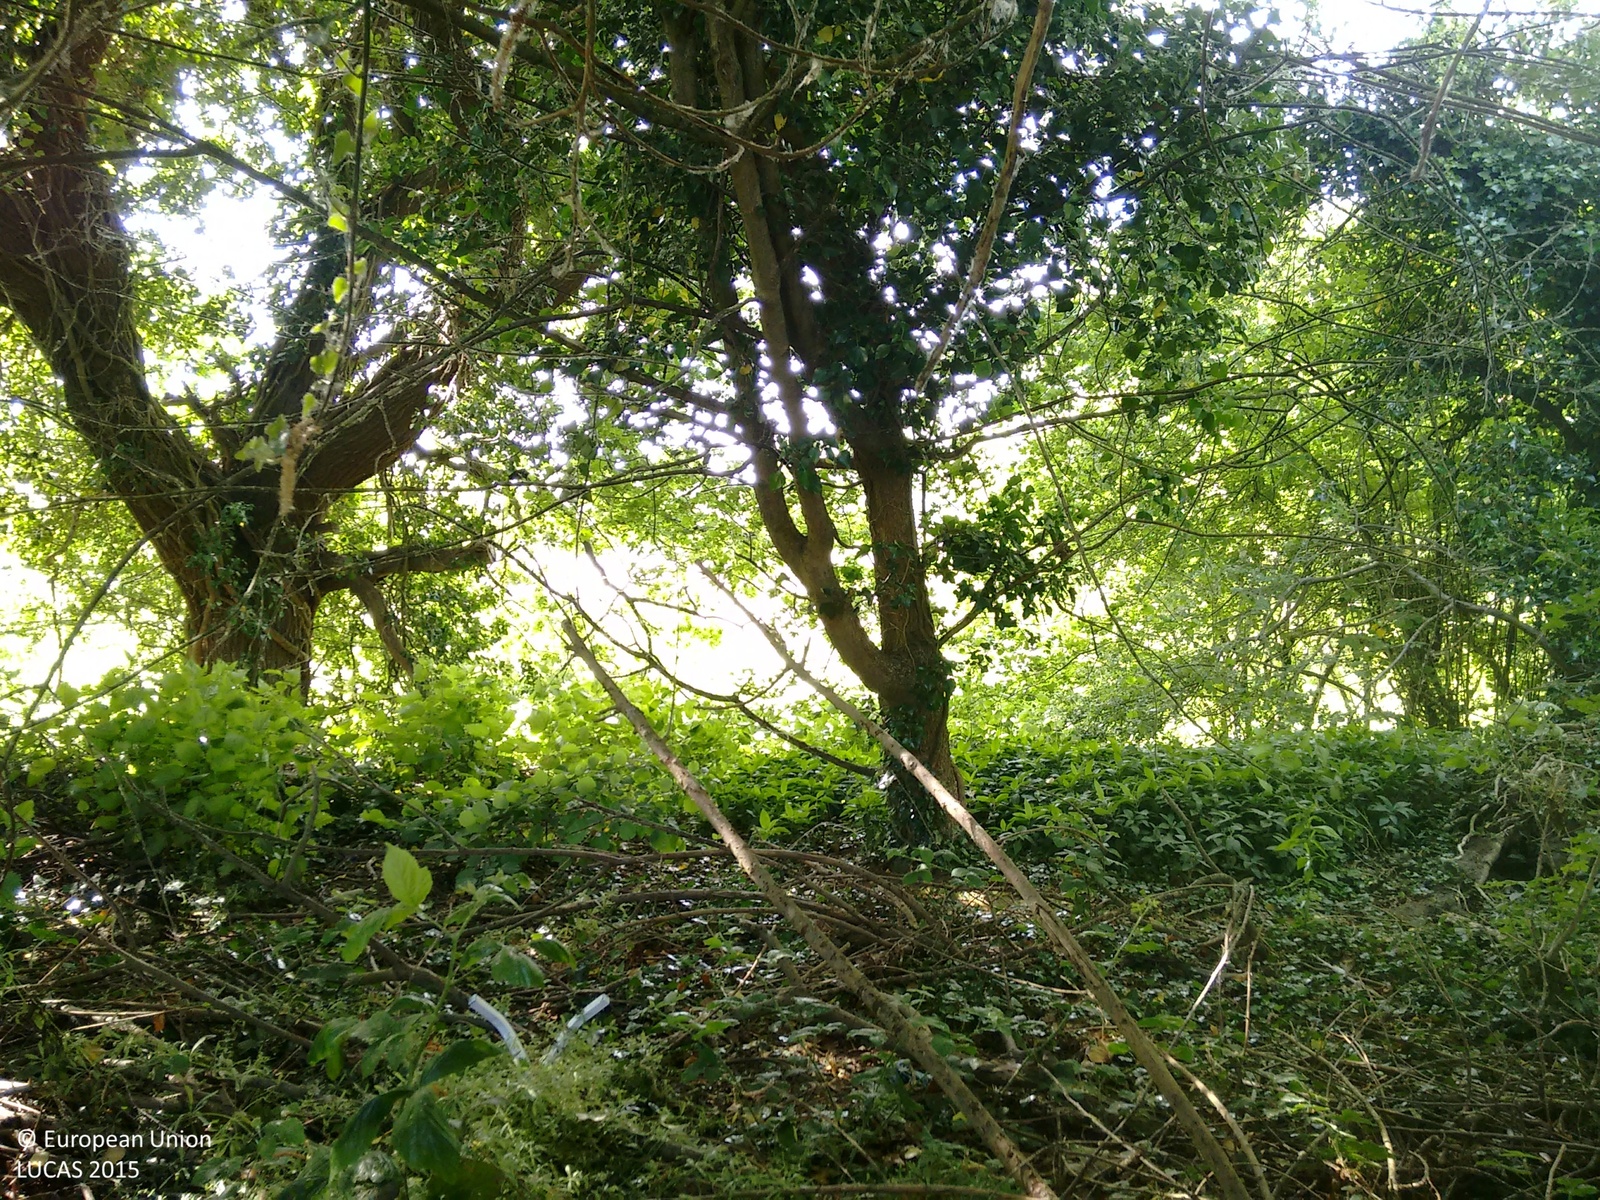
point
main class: Woodland
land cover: Broadleaved woodland
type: mesophytic deciduous forest
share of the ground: > 75 %
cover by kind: broadleaved forest trees 60 %, shrubs 40 %
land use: Semi-natural and natural areas not in use
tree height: > 5 m
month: June
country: GB
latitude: 50.8572
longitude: 0.5255
